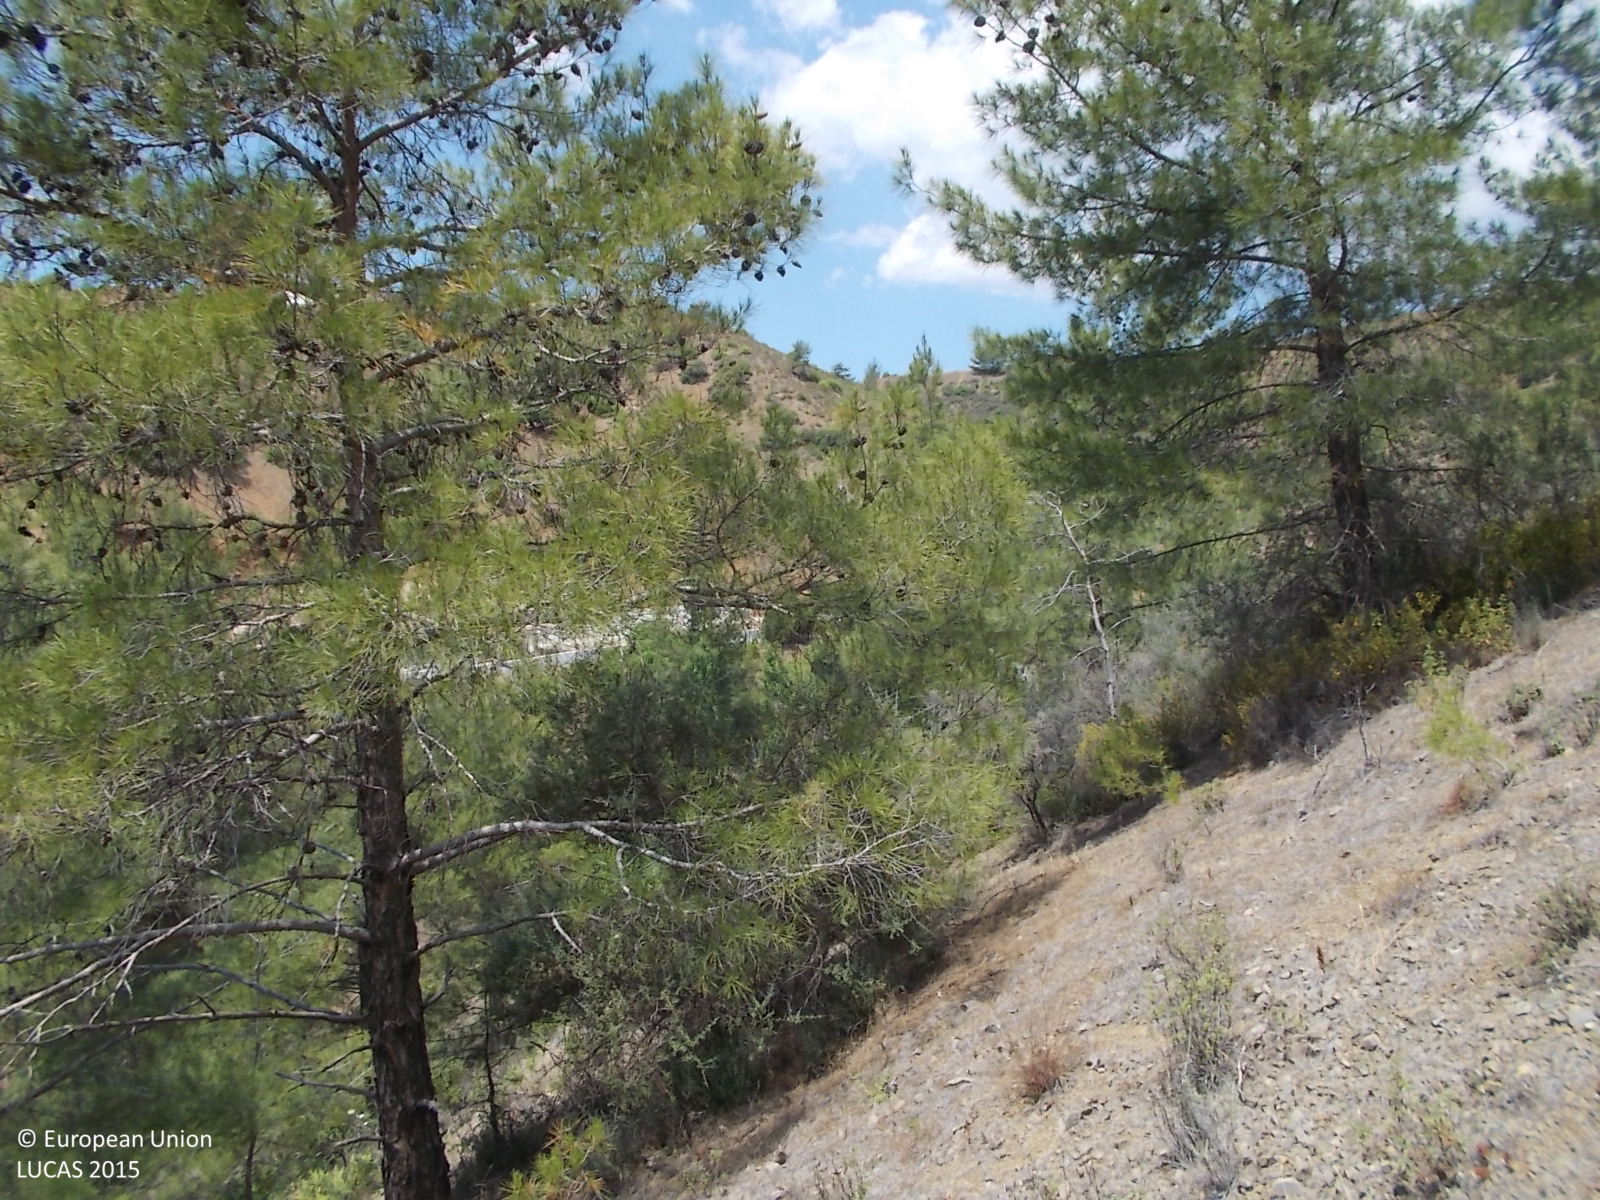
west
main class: Woodland
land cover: Pine dominated coniferous woodland
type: coniferous forest of the mediterranean region
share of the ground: 25 - 50 %
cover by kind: coniferous forest trees 40 %, unconsolidated bare surface 40 %, shrubs 20 %
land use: Forestry
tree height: > 5 m
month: June
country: CY
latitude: 34.8772
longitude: 32.8205
